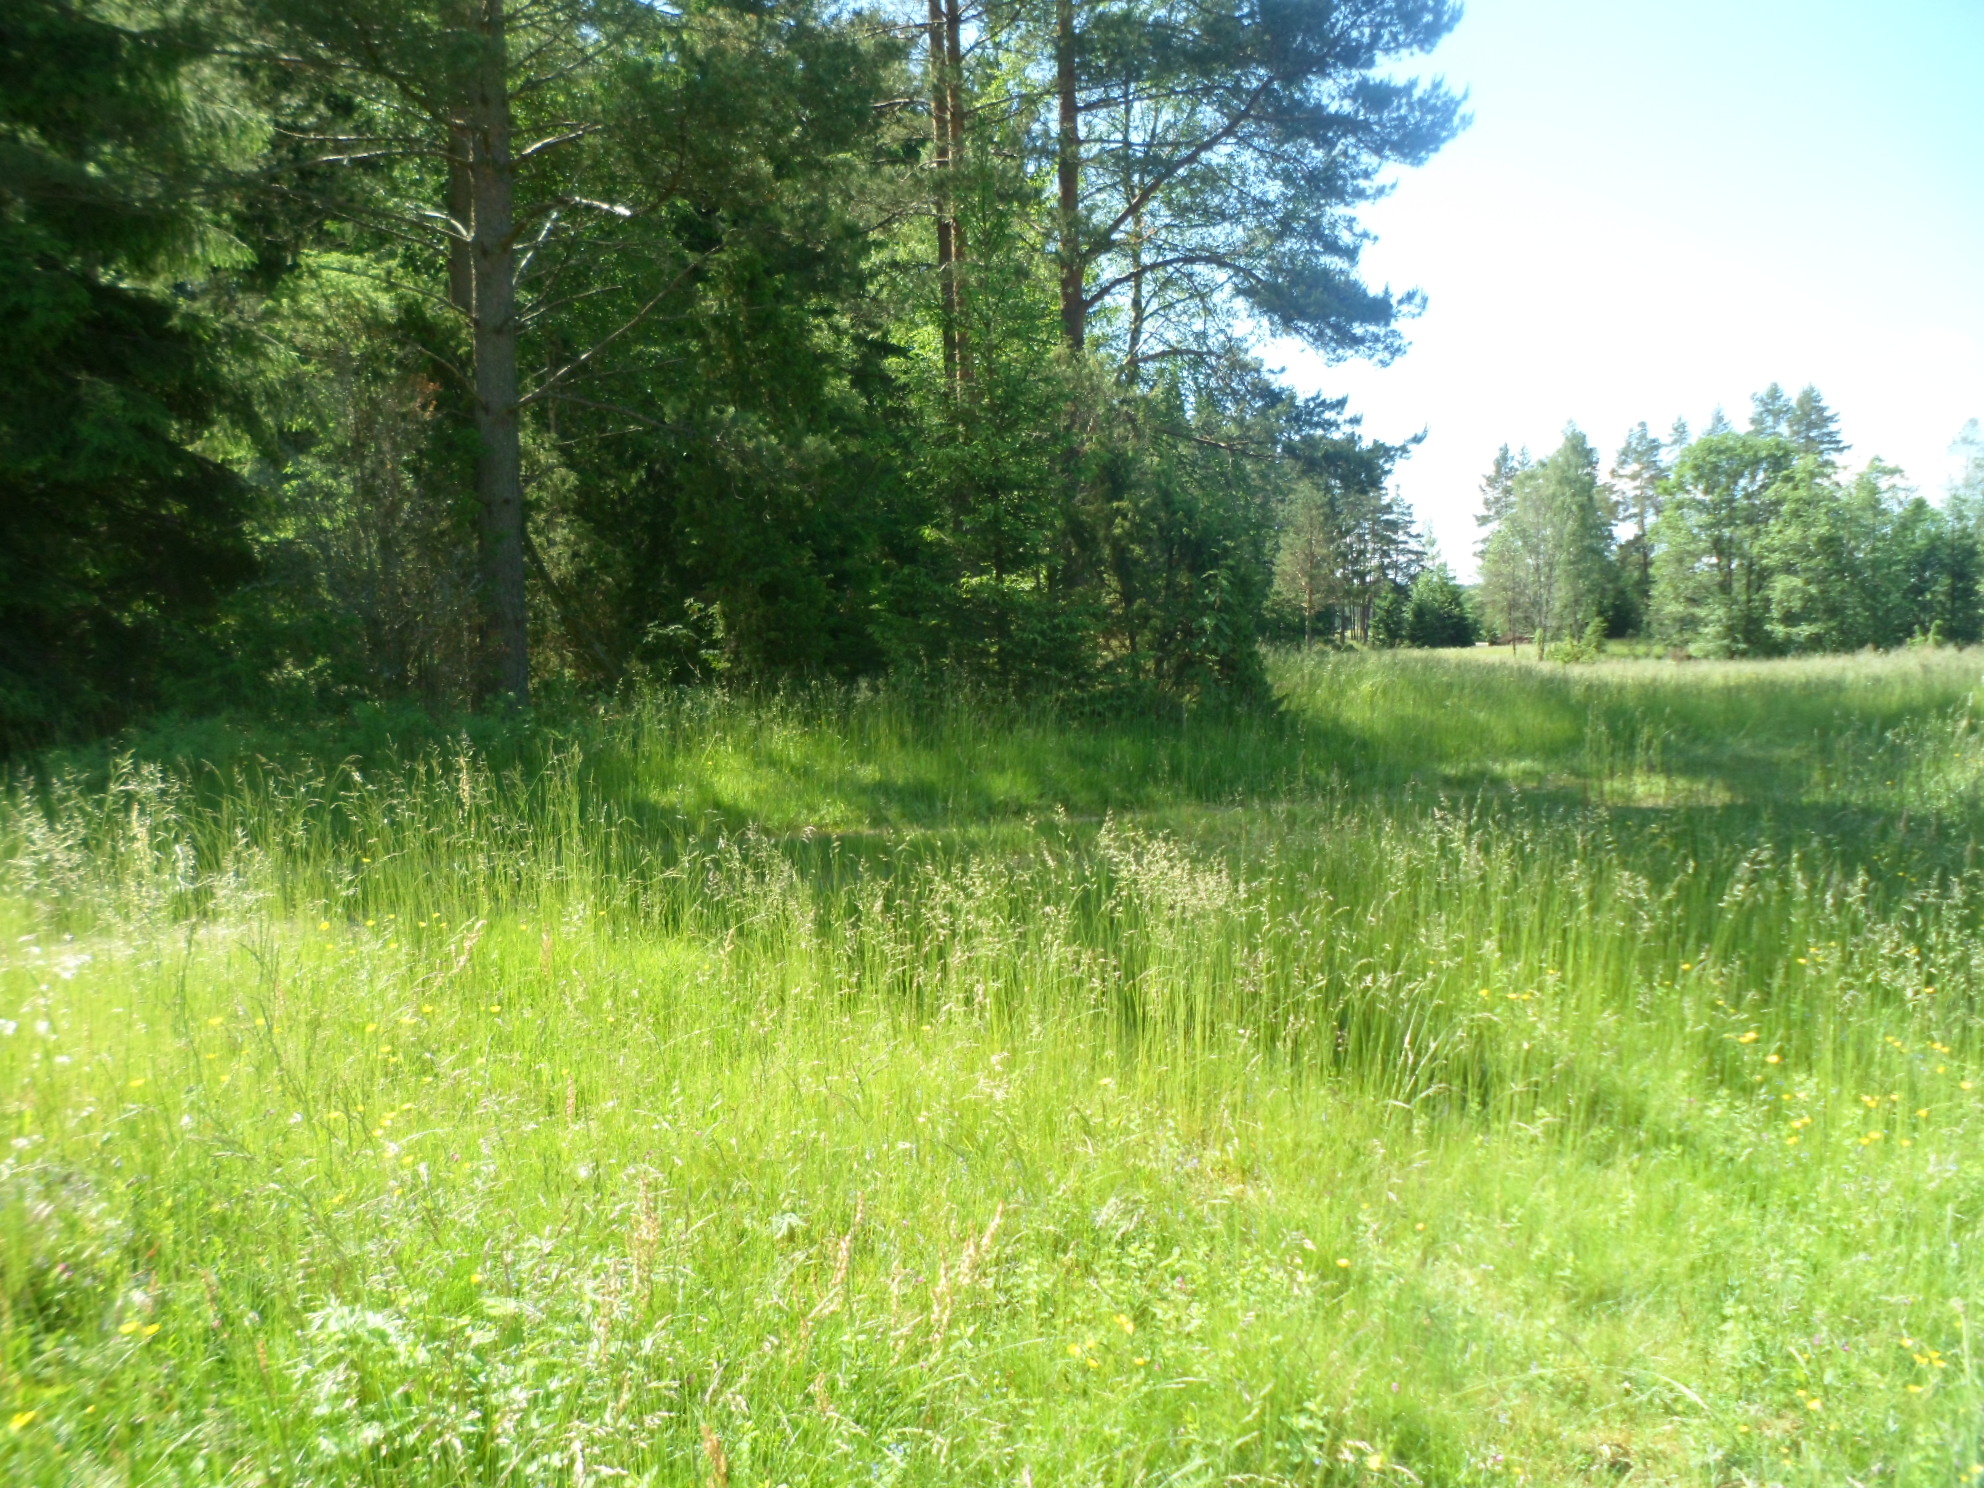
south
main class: Grassland
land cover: Grassland without tree/shrub cover
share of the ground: > 75 %
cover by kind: herbaceous plants 100 %
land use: Agriculture (excluding fallow land and kitchen gardens)
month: July
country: SE
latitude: 57.3695
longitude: 14.5021
